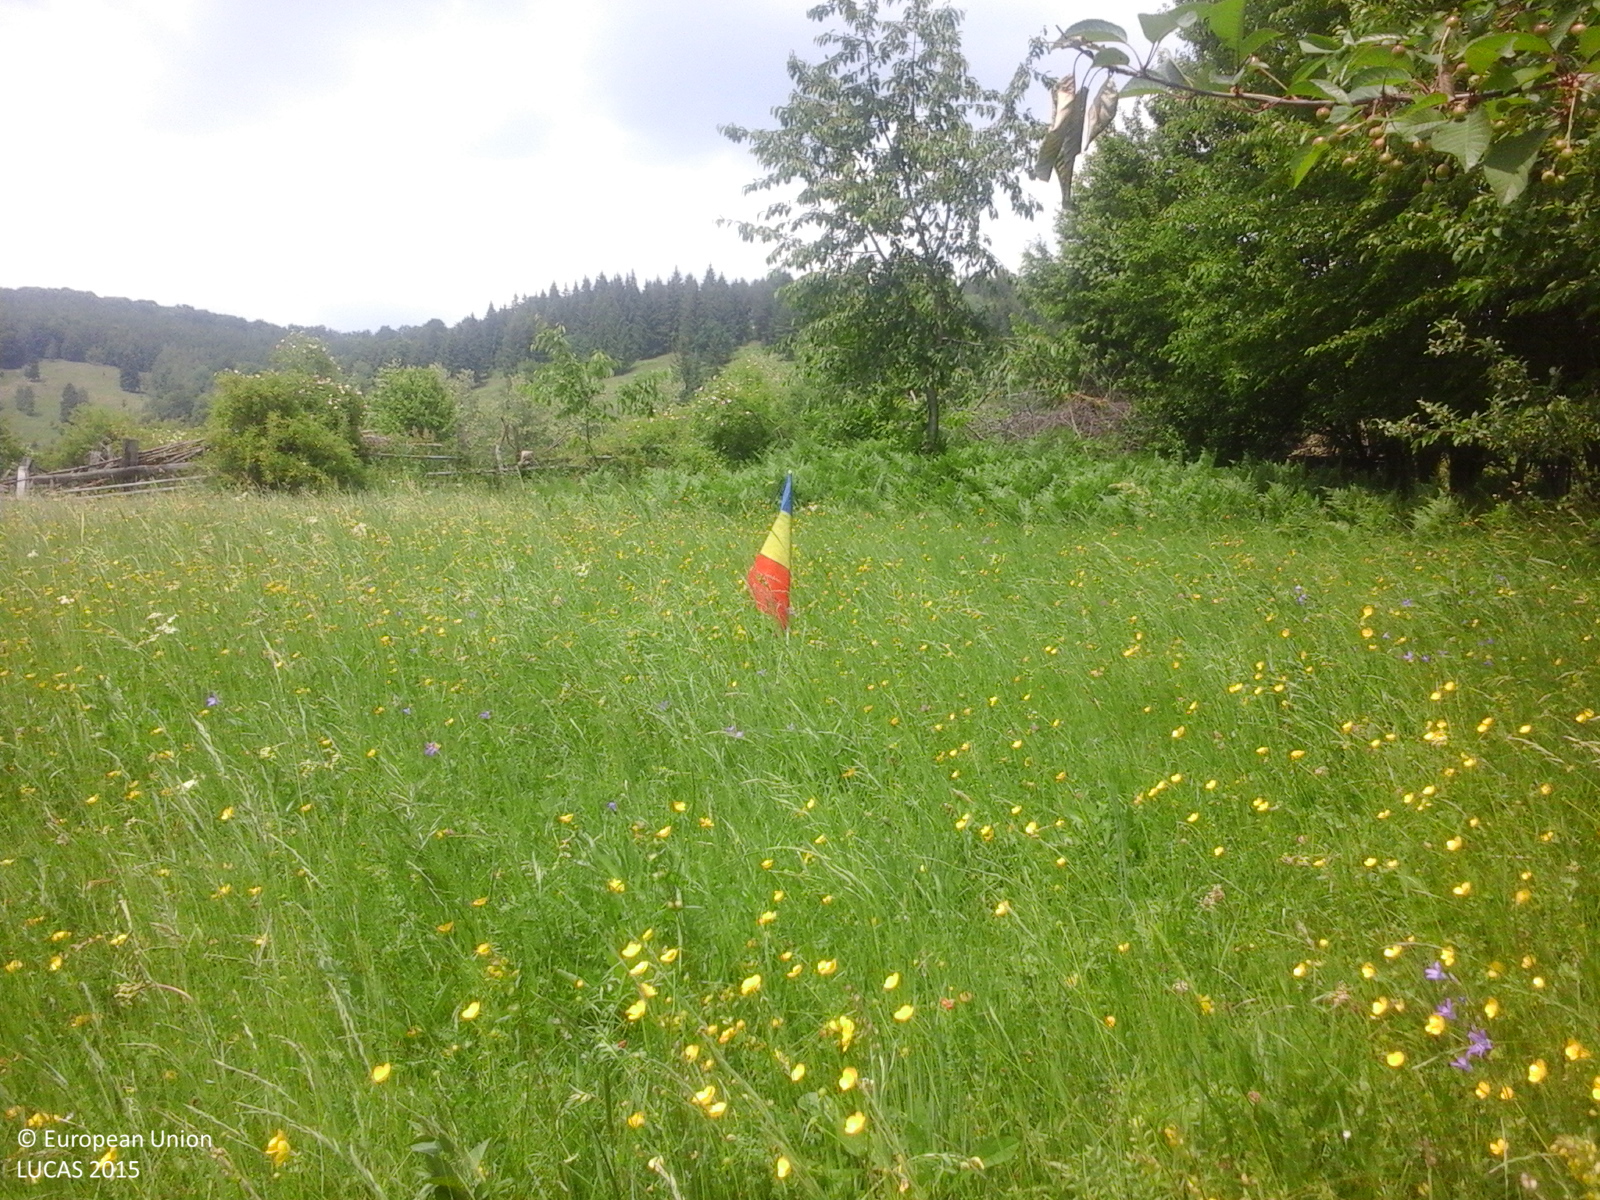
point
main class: Grassland
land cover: Grassland without tree/shrub cover
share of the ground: > 75 %
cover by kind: herbaceous plants 100 %
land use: Agriculture (excluding fallow land and kitchen gardens)
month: June
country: RO
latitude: 46.3575
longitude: 26.4151
